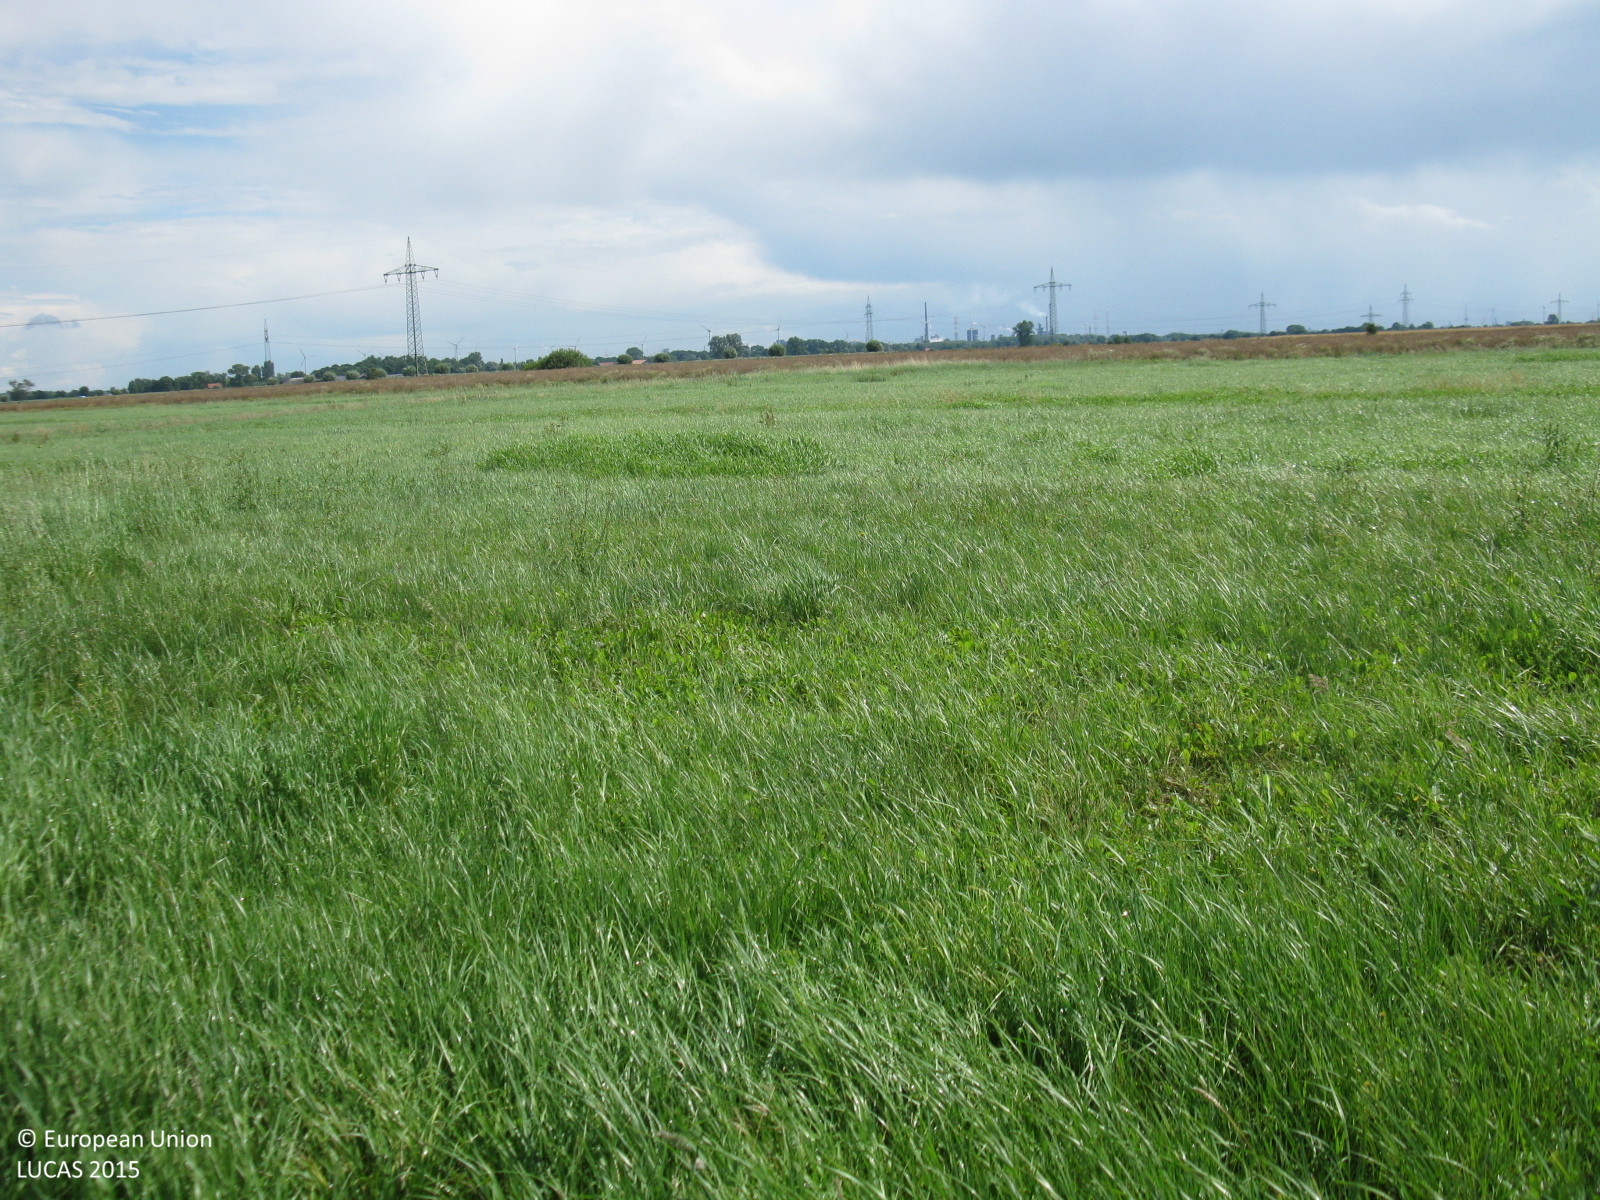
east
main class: Grassland
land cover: Grassland without tree/shrub cover
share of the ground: > 75 %
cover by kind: herbaceous plants 100 %
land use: Agriculture (excluding fallow land and kitchen gardens)
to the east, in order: Ditches and canals; Grassland without tree/shrub cover; Ditches and canals; Rape and turnip rape; Grass margins; Ditches and canals; Grass margins; Temporary grasslands
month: July
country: DE
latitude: 53.1240
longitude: 8.5809
